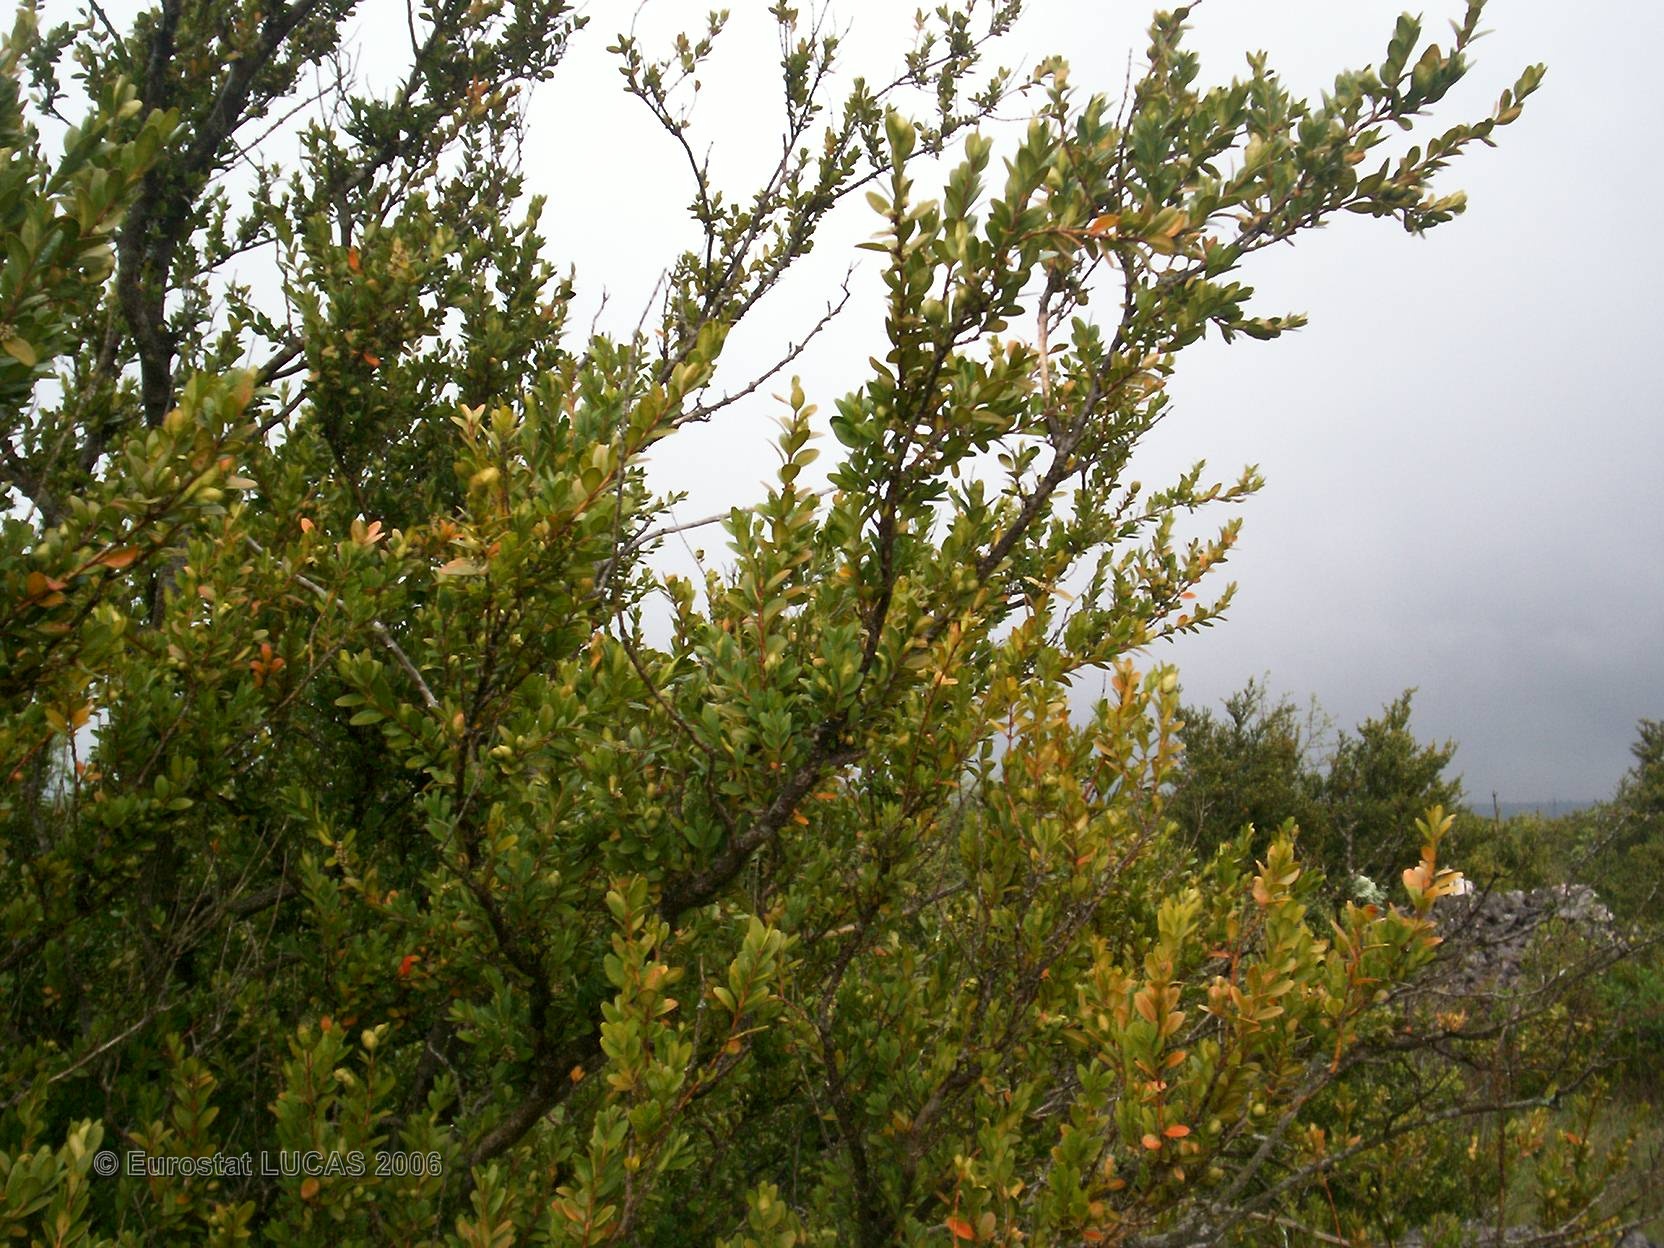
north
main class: Shrubland
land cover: Shrubland without tree cover
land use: Unused
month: May
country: FR
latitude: 43.9291
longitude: 3.4929
